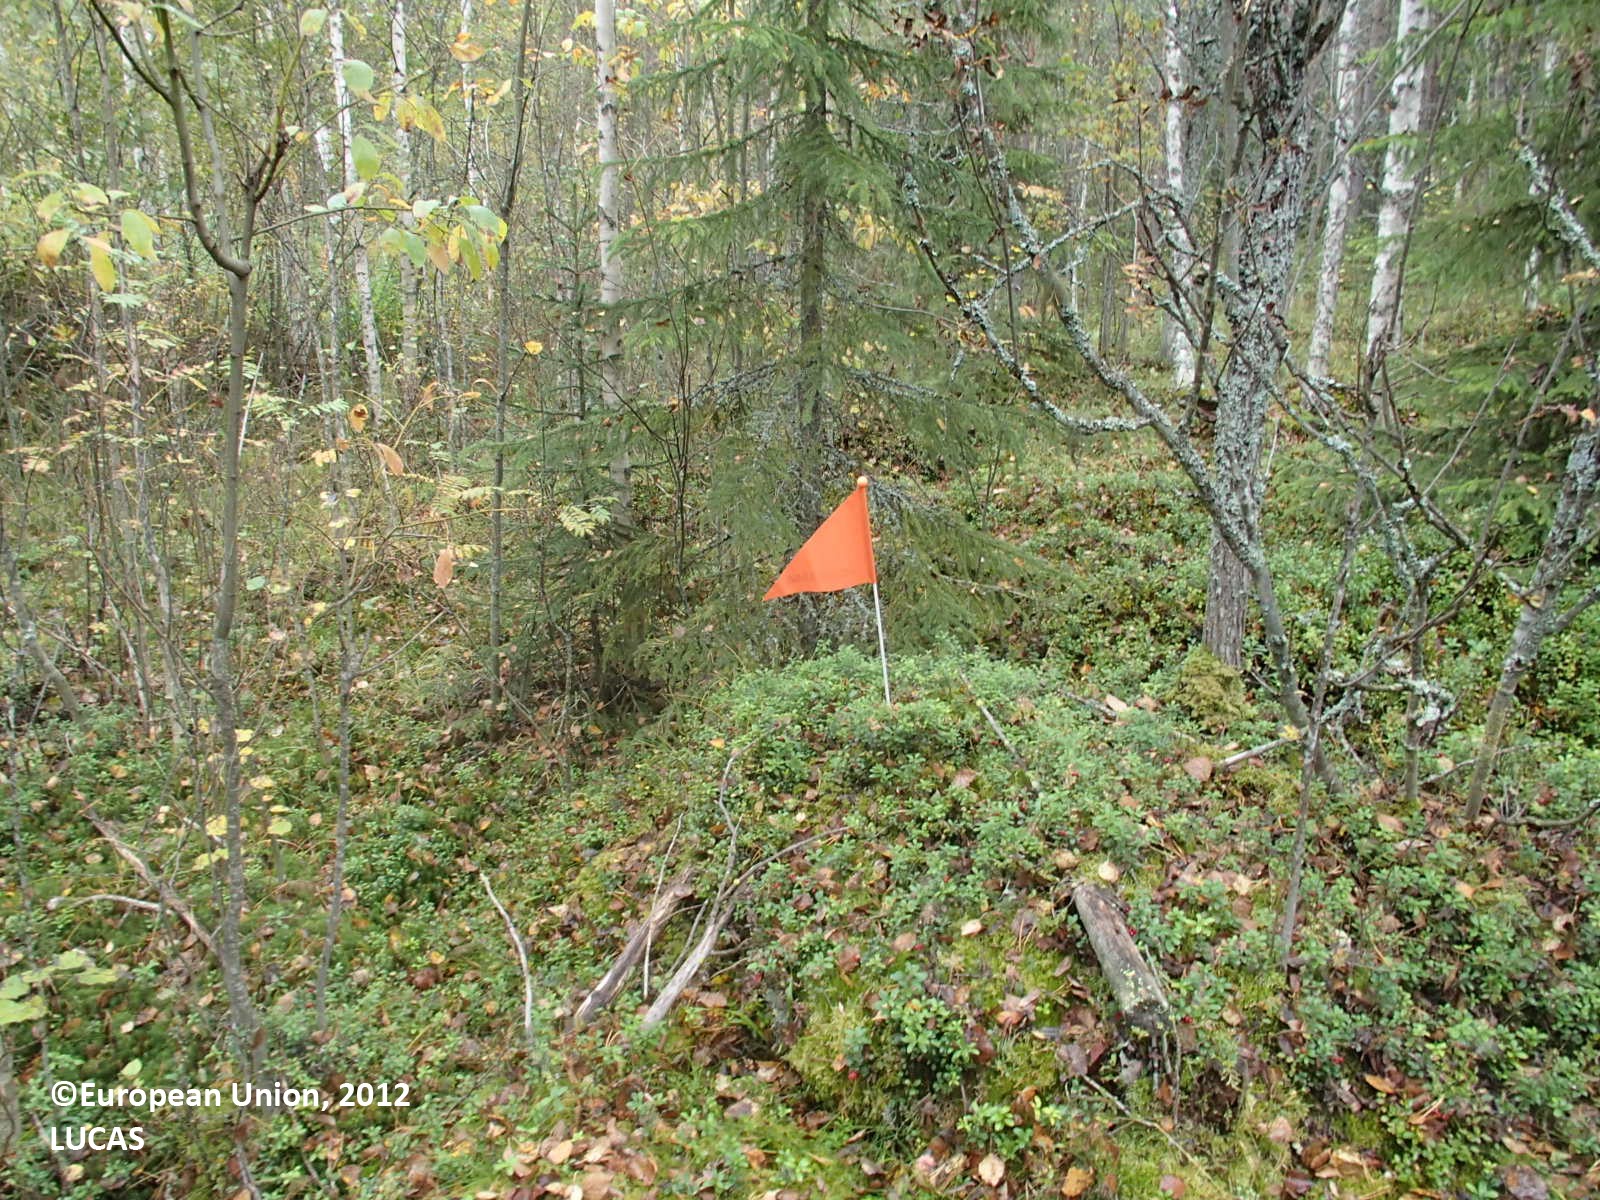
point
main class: Woodland
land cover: Spruce dominated mixed woodland
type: boreal forest
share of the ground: 50 - 75 %
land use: Forestry
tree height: > 5 m
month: September
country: FI
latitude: 63.8685
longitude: 26.9231
